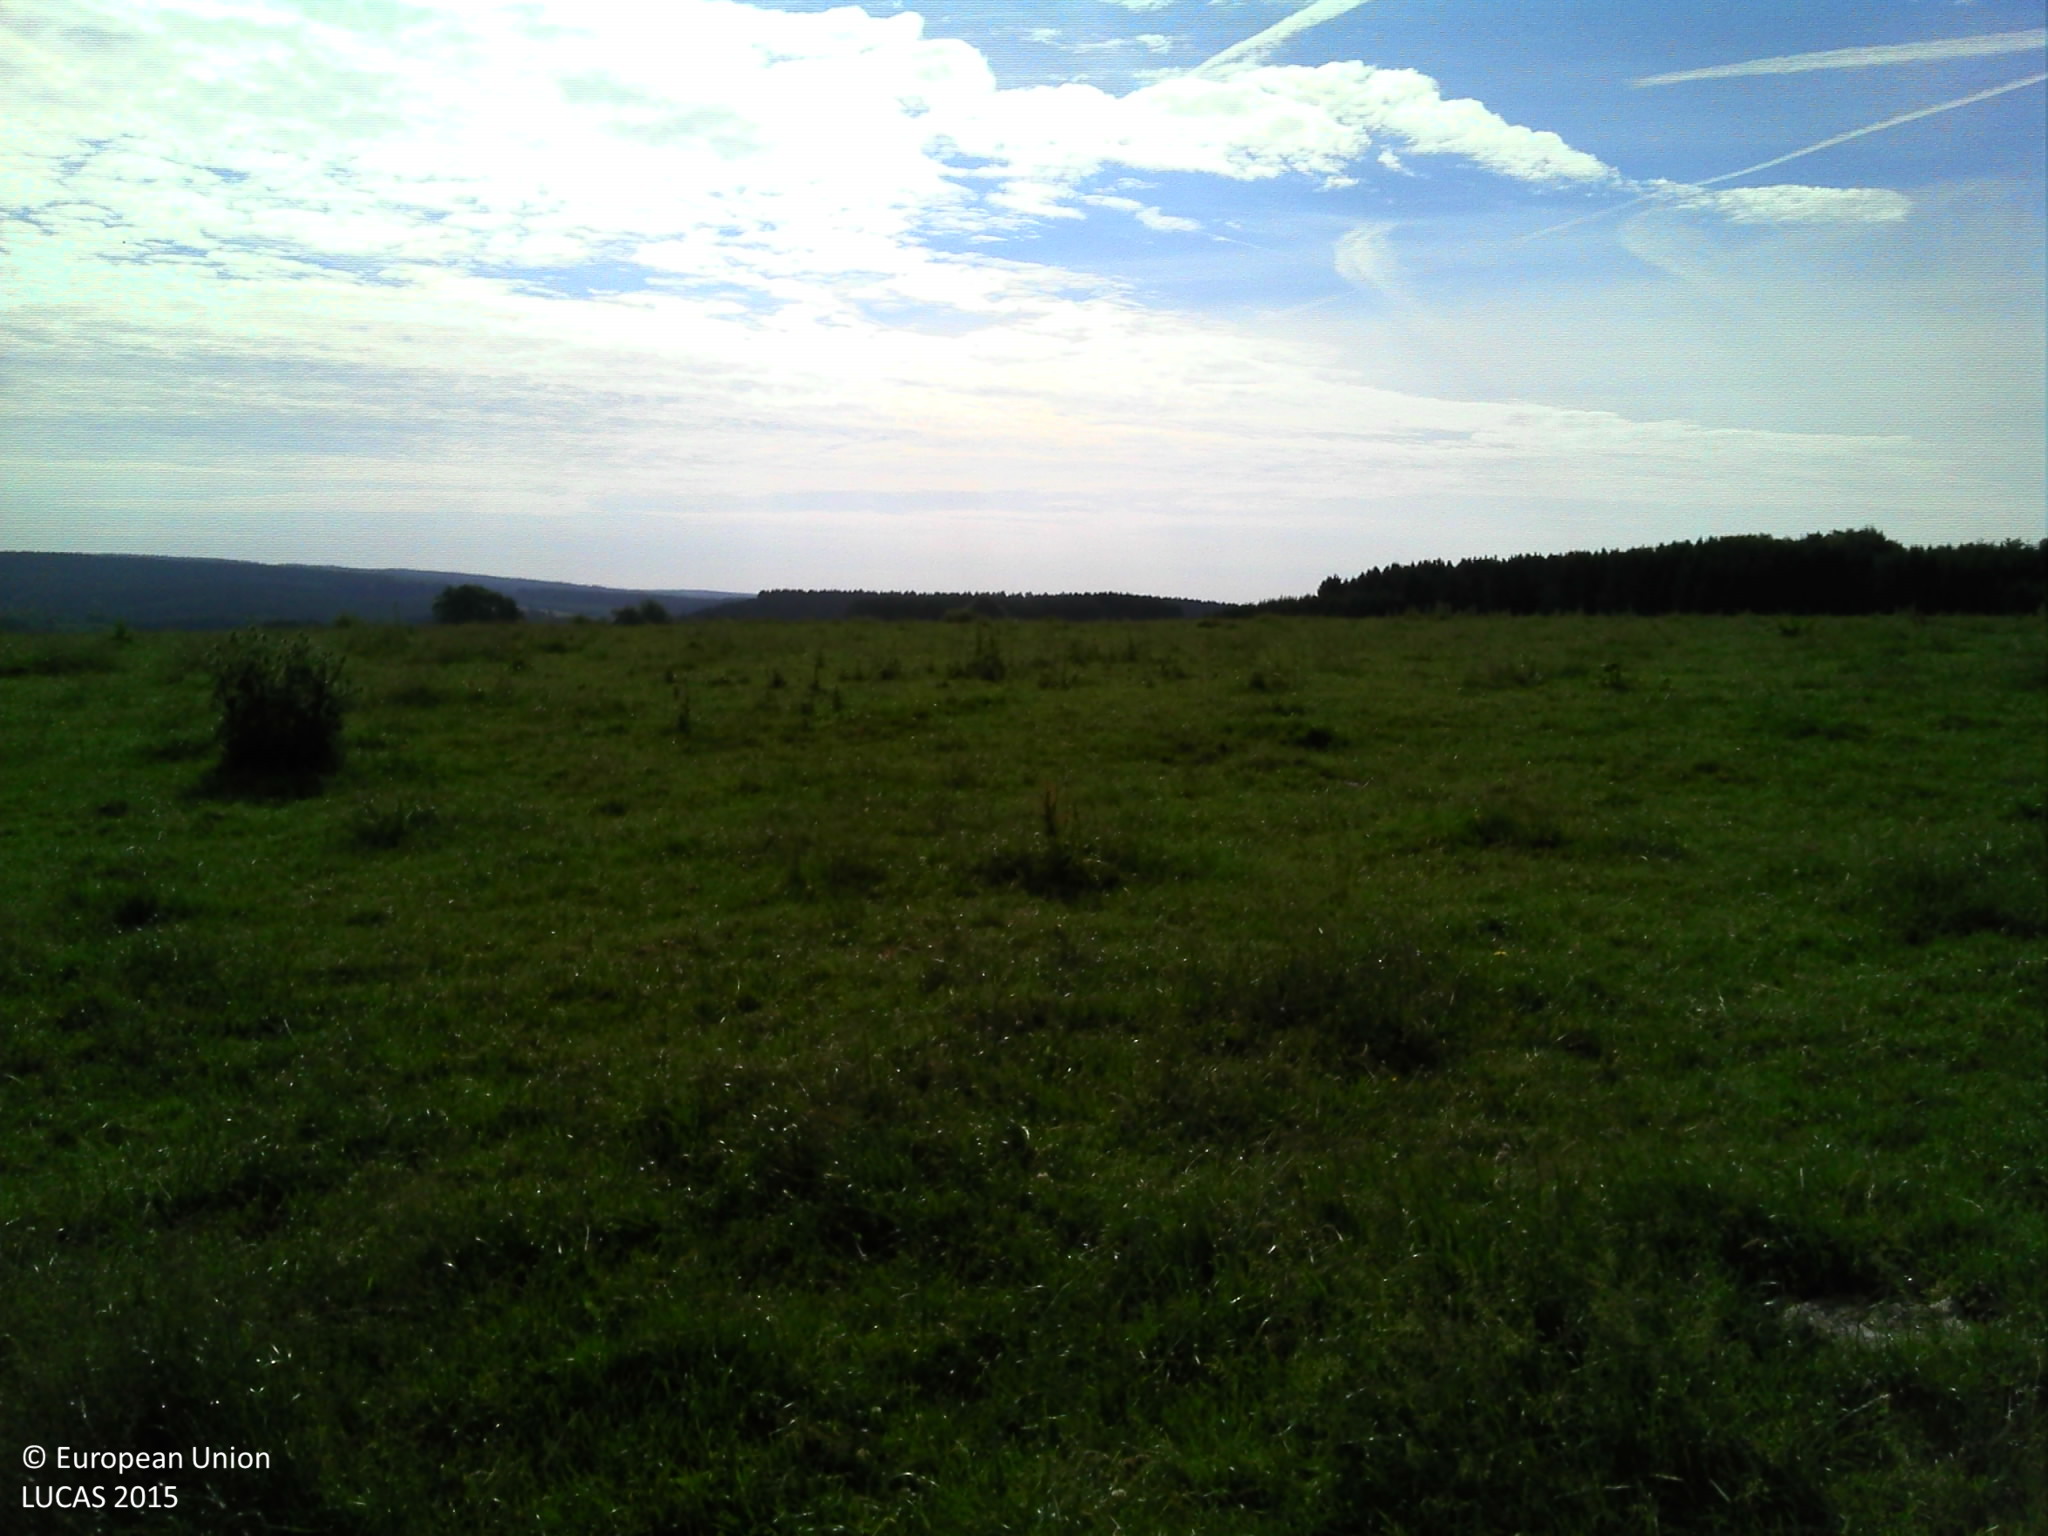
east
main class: Grassland
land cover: Grassland without tree/shrub cover
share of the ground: > 75 %
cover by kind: herbaceous plants 100 %
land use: Agriculture (excluding fallow land and kitchen gardens)
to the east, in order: Grassland without tree/shrub cover
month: June
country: BE
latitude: 49.9399
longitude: 5.2185
